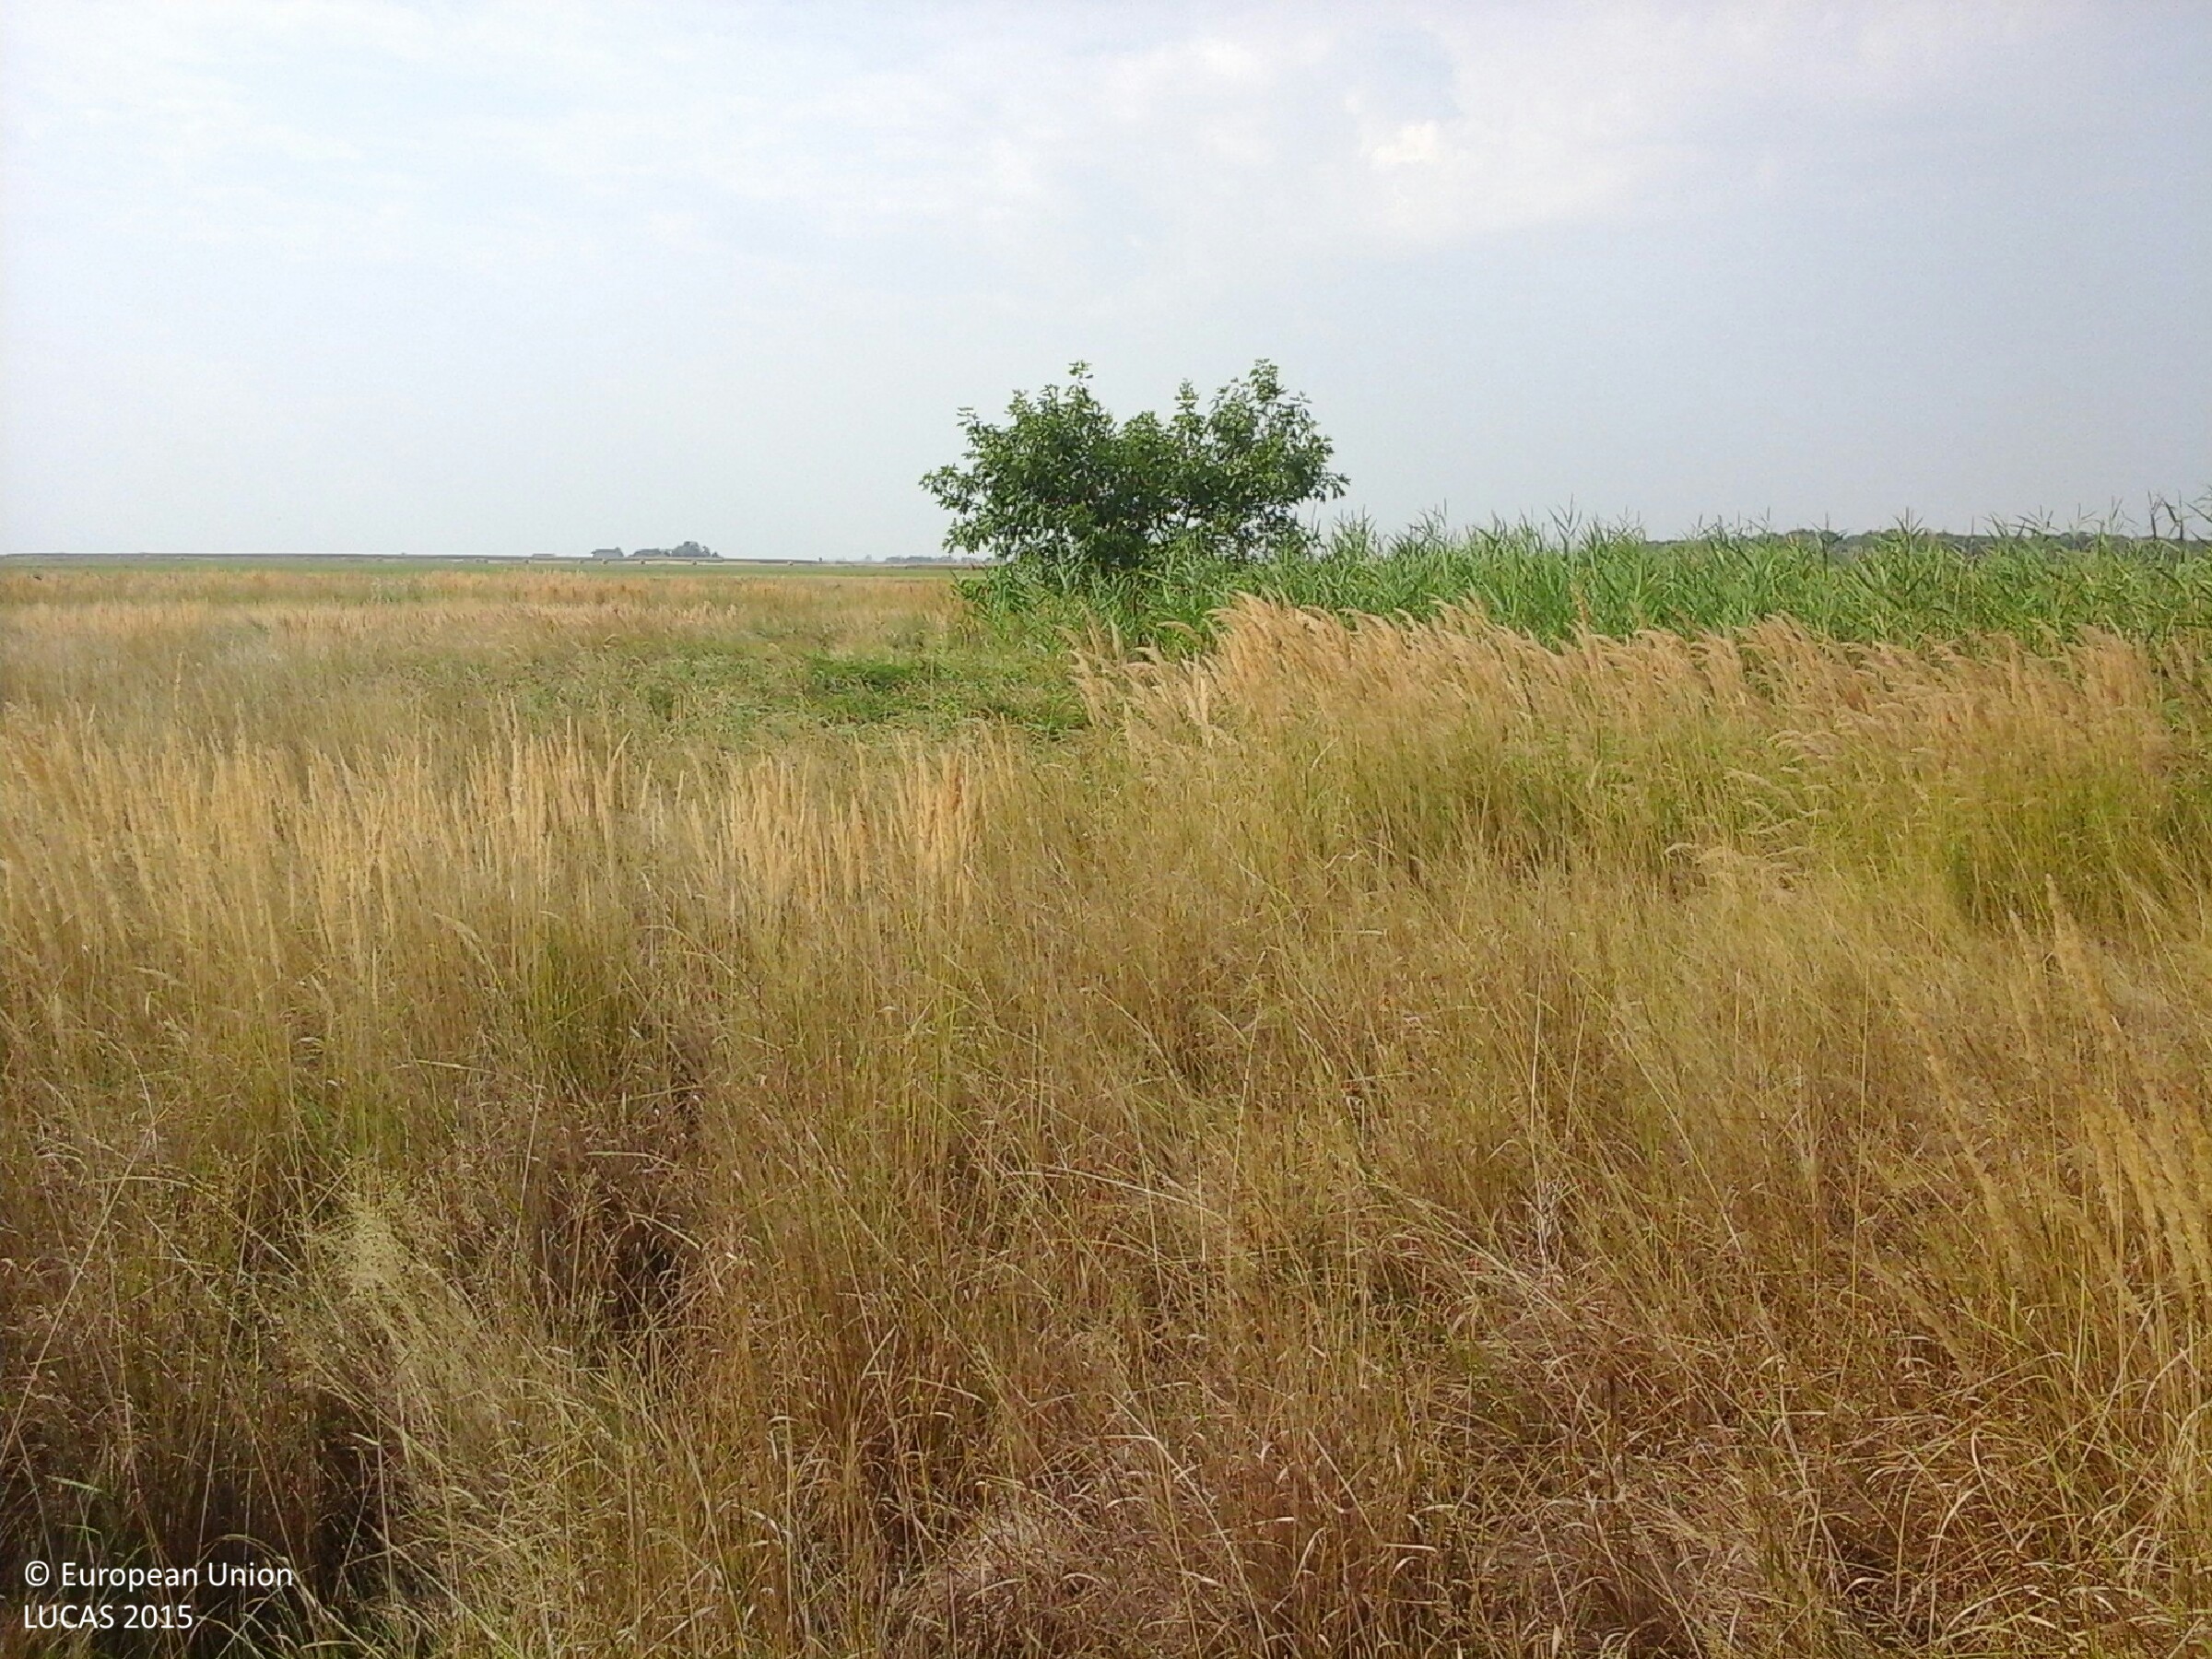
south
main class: Grassland
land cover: Grassland without tree/shrub cover
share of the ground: > 75 %
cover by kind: herbaceous plants 100 %
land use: Agriculture (excluding fallow land and kitchen gardens)
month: August
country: HU
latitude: 47.5497
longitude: 20.9454
